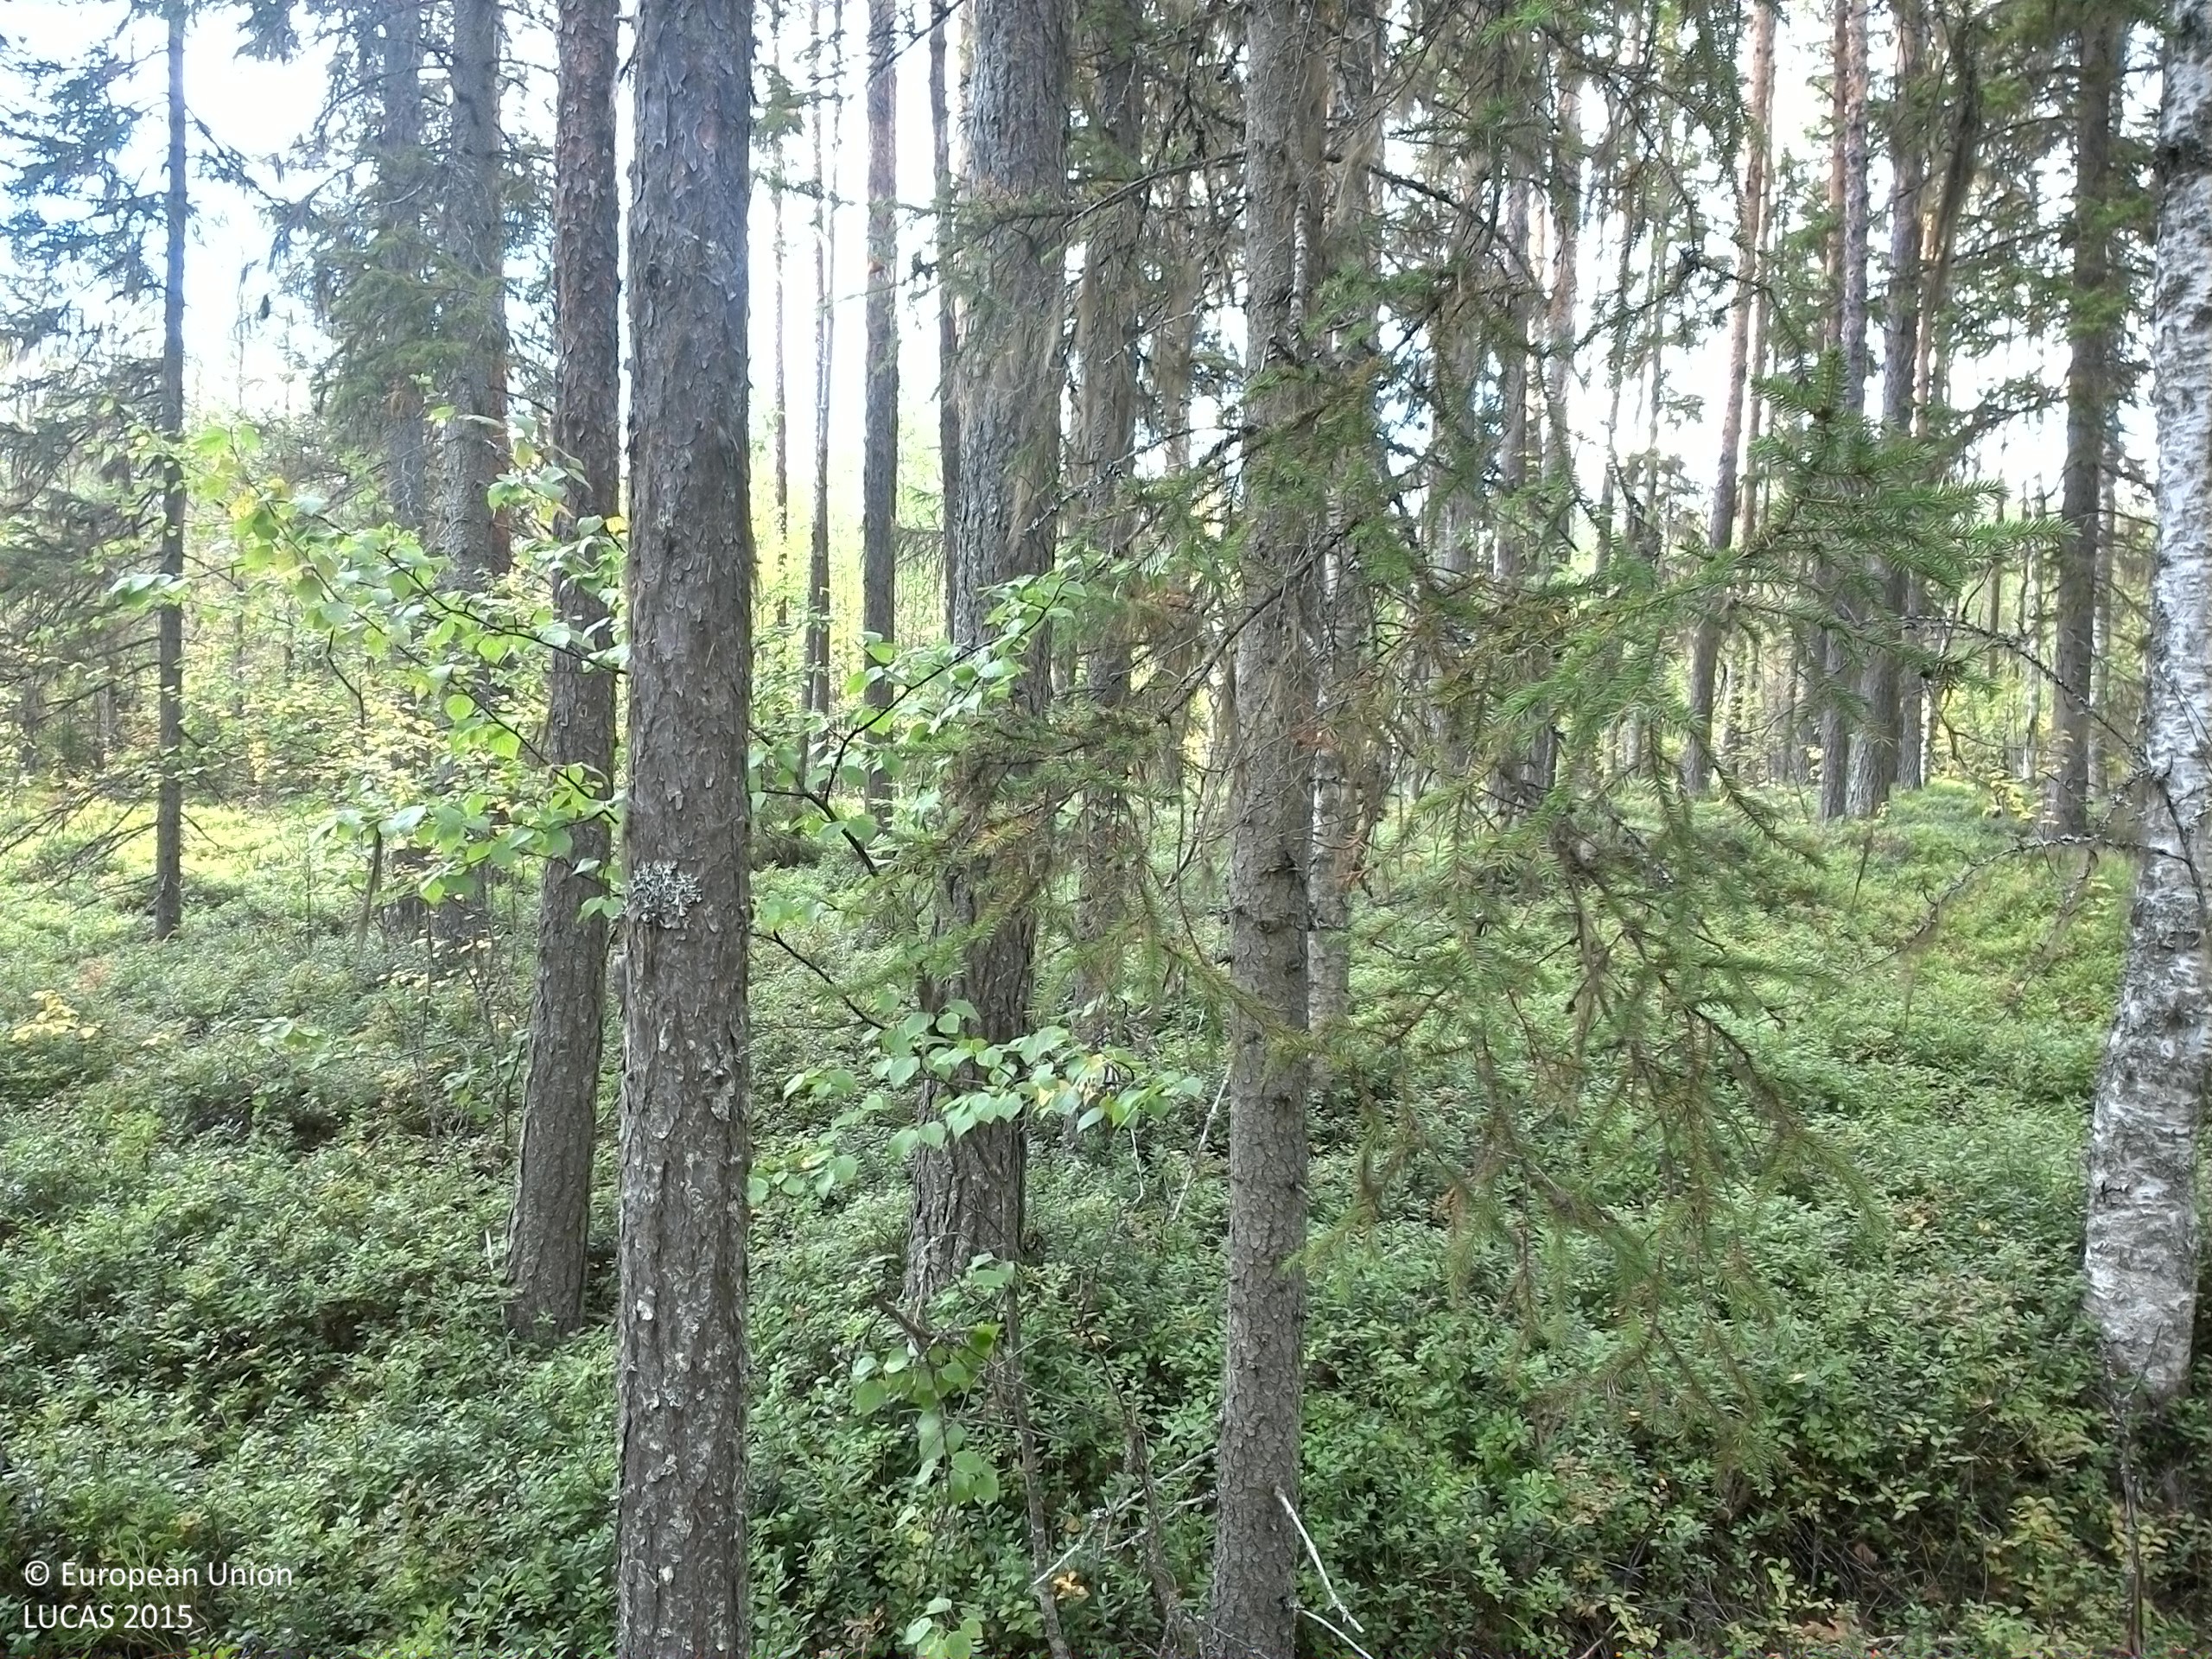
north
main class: Woodland
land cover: Spruce dominated mixed woodland
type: boreal forest
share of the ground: 50 - 75 %
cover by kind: coniferous forest trees 40 %, shrubs 35 %, broadleaved forest trees 15 %, lichens and mosses 10 %
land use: Forestry
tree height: > 5 m
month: September
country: SE
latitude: 63.8662
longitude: 16.5036
